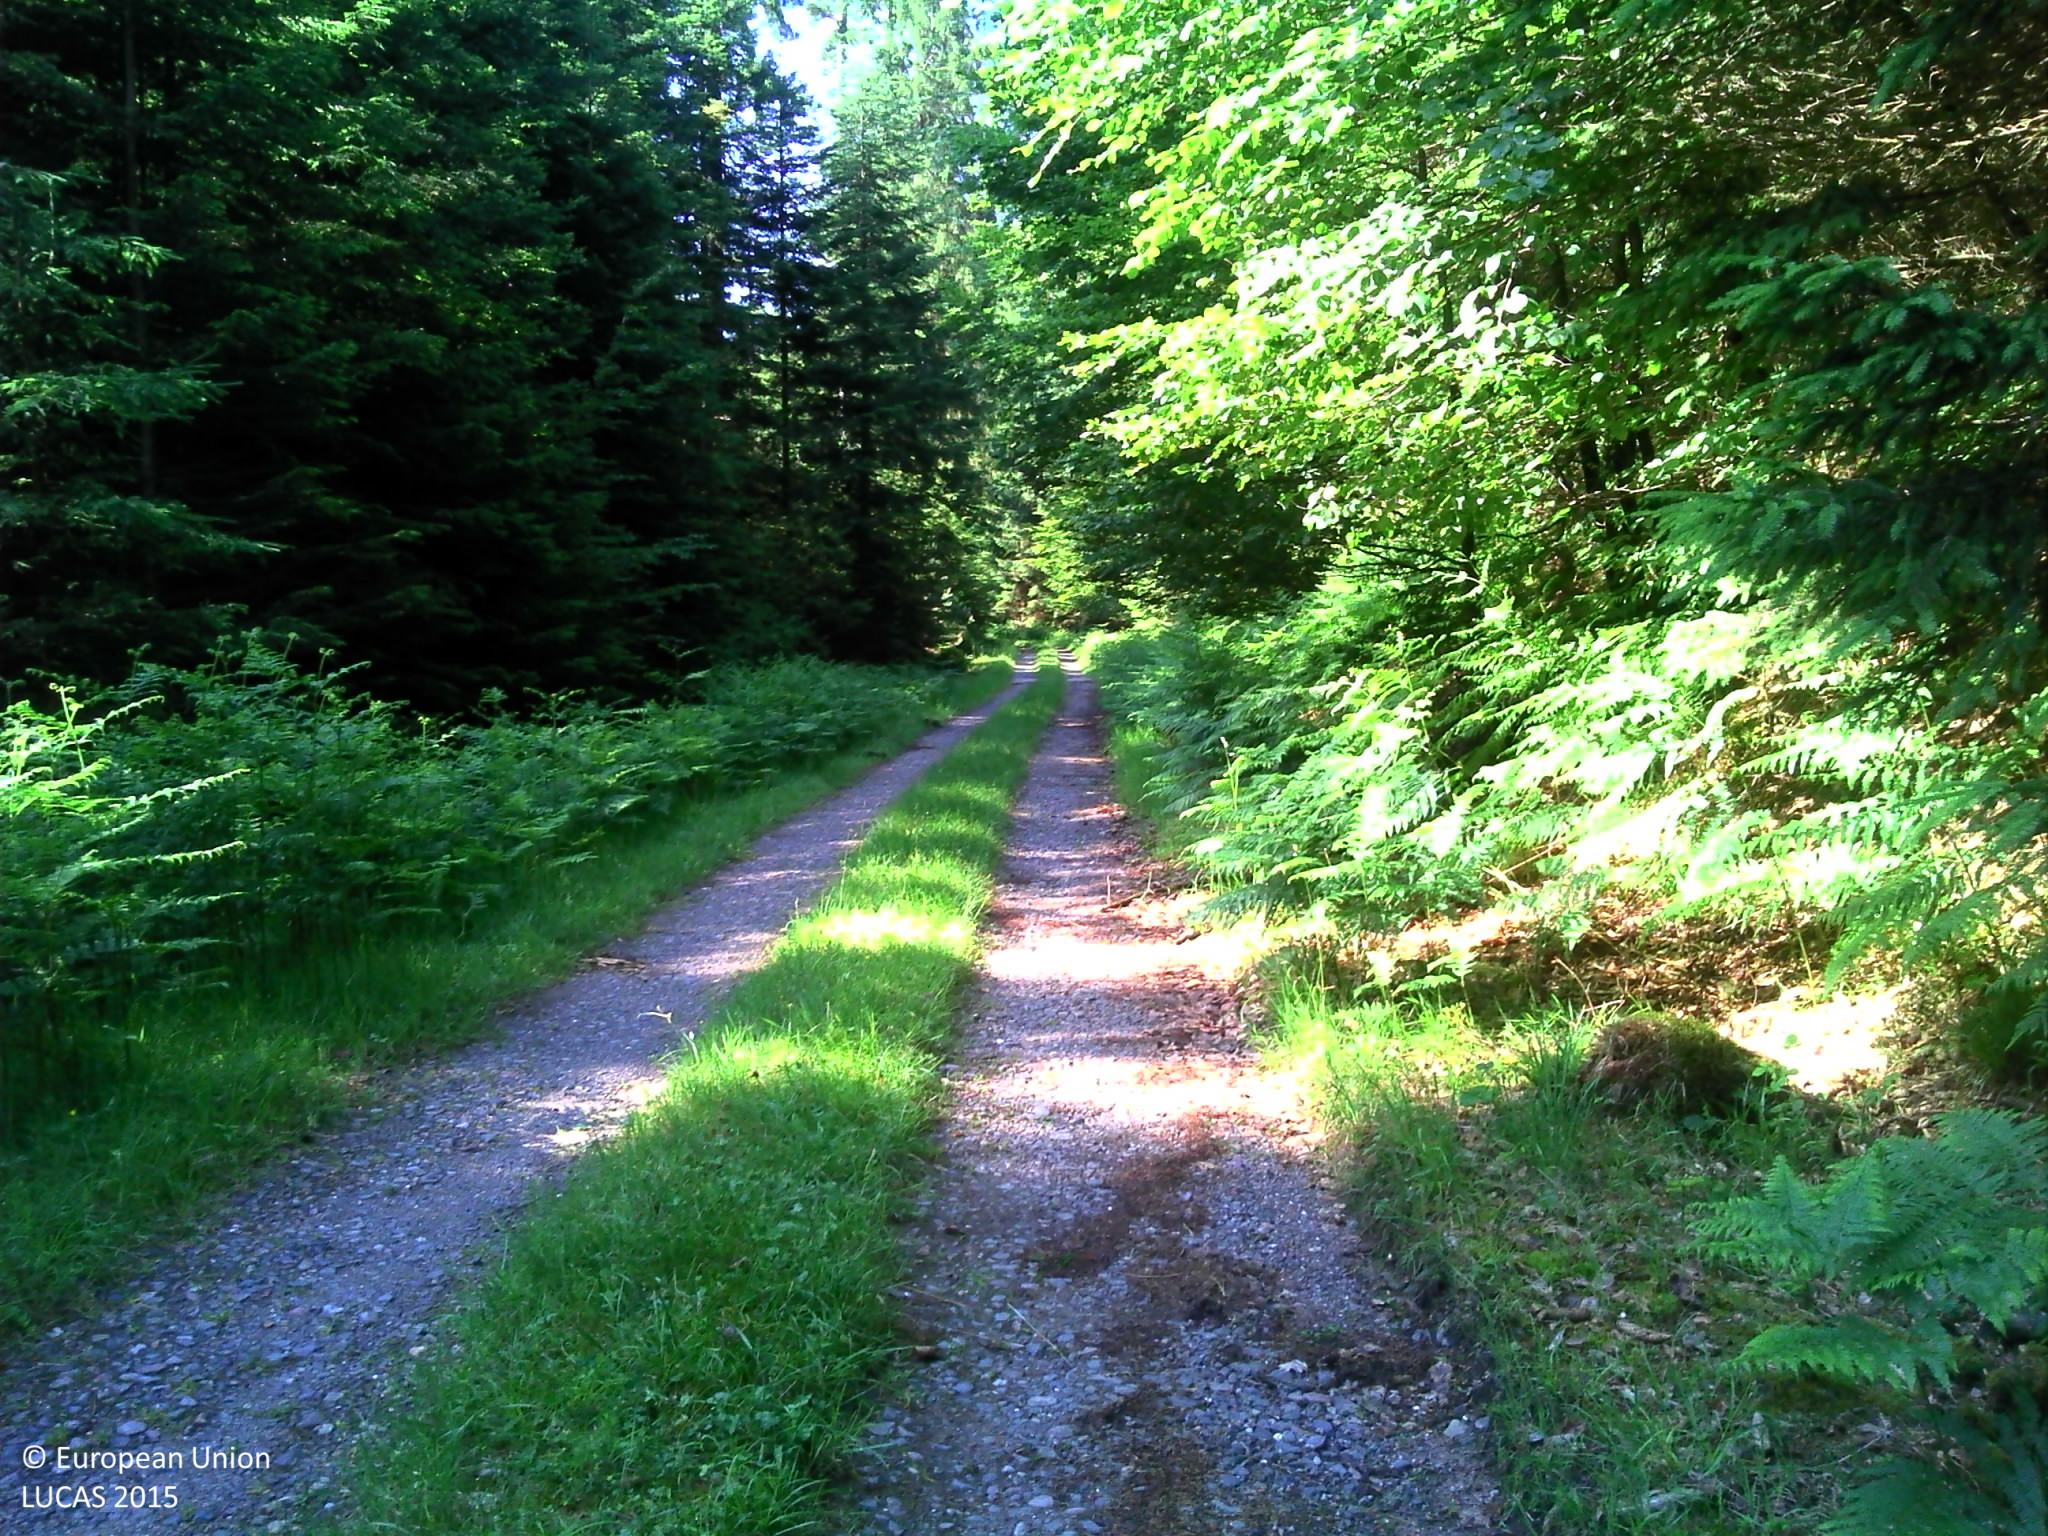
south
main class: Woodland
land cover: Spruce dominated coniferous woodland
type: alpine coniferous forest
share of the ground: > 75 %
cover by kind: coniferous forest trees 90 %, herbaceous plants 10 %
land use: Forestry
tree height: > 5 m
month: June
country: FR
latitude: 48.6759
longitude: 7.2710
